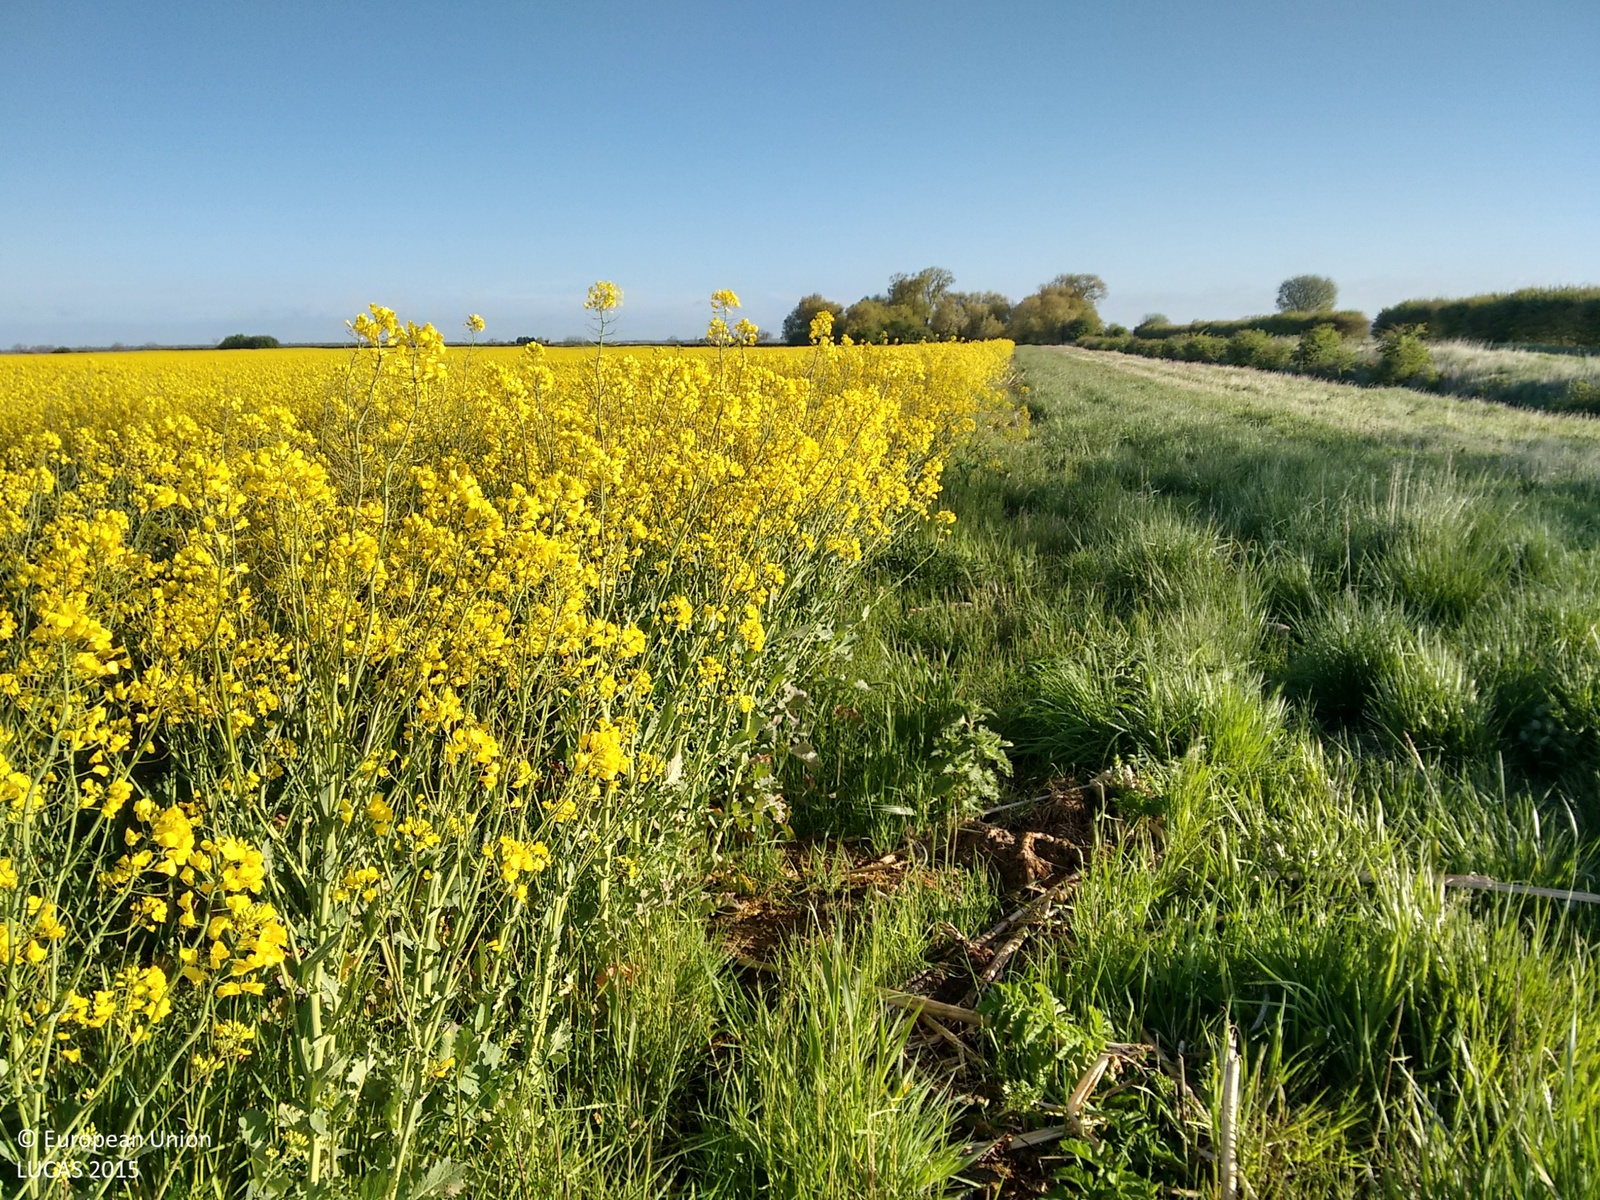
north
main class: Cropland
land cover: Rape and turnip rape
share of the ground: > 75 %
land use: Agriculture (excluding fallow land and kitchen gardens)
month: May
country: GB
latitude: 53.0711
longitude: -0.0776
